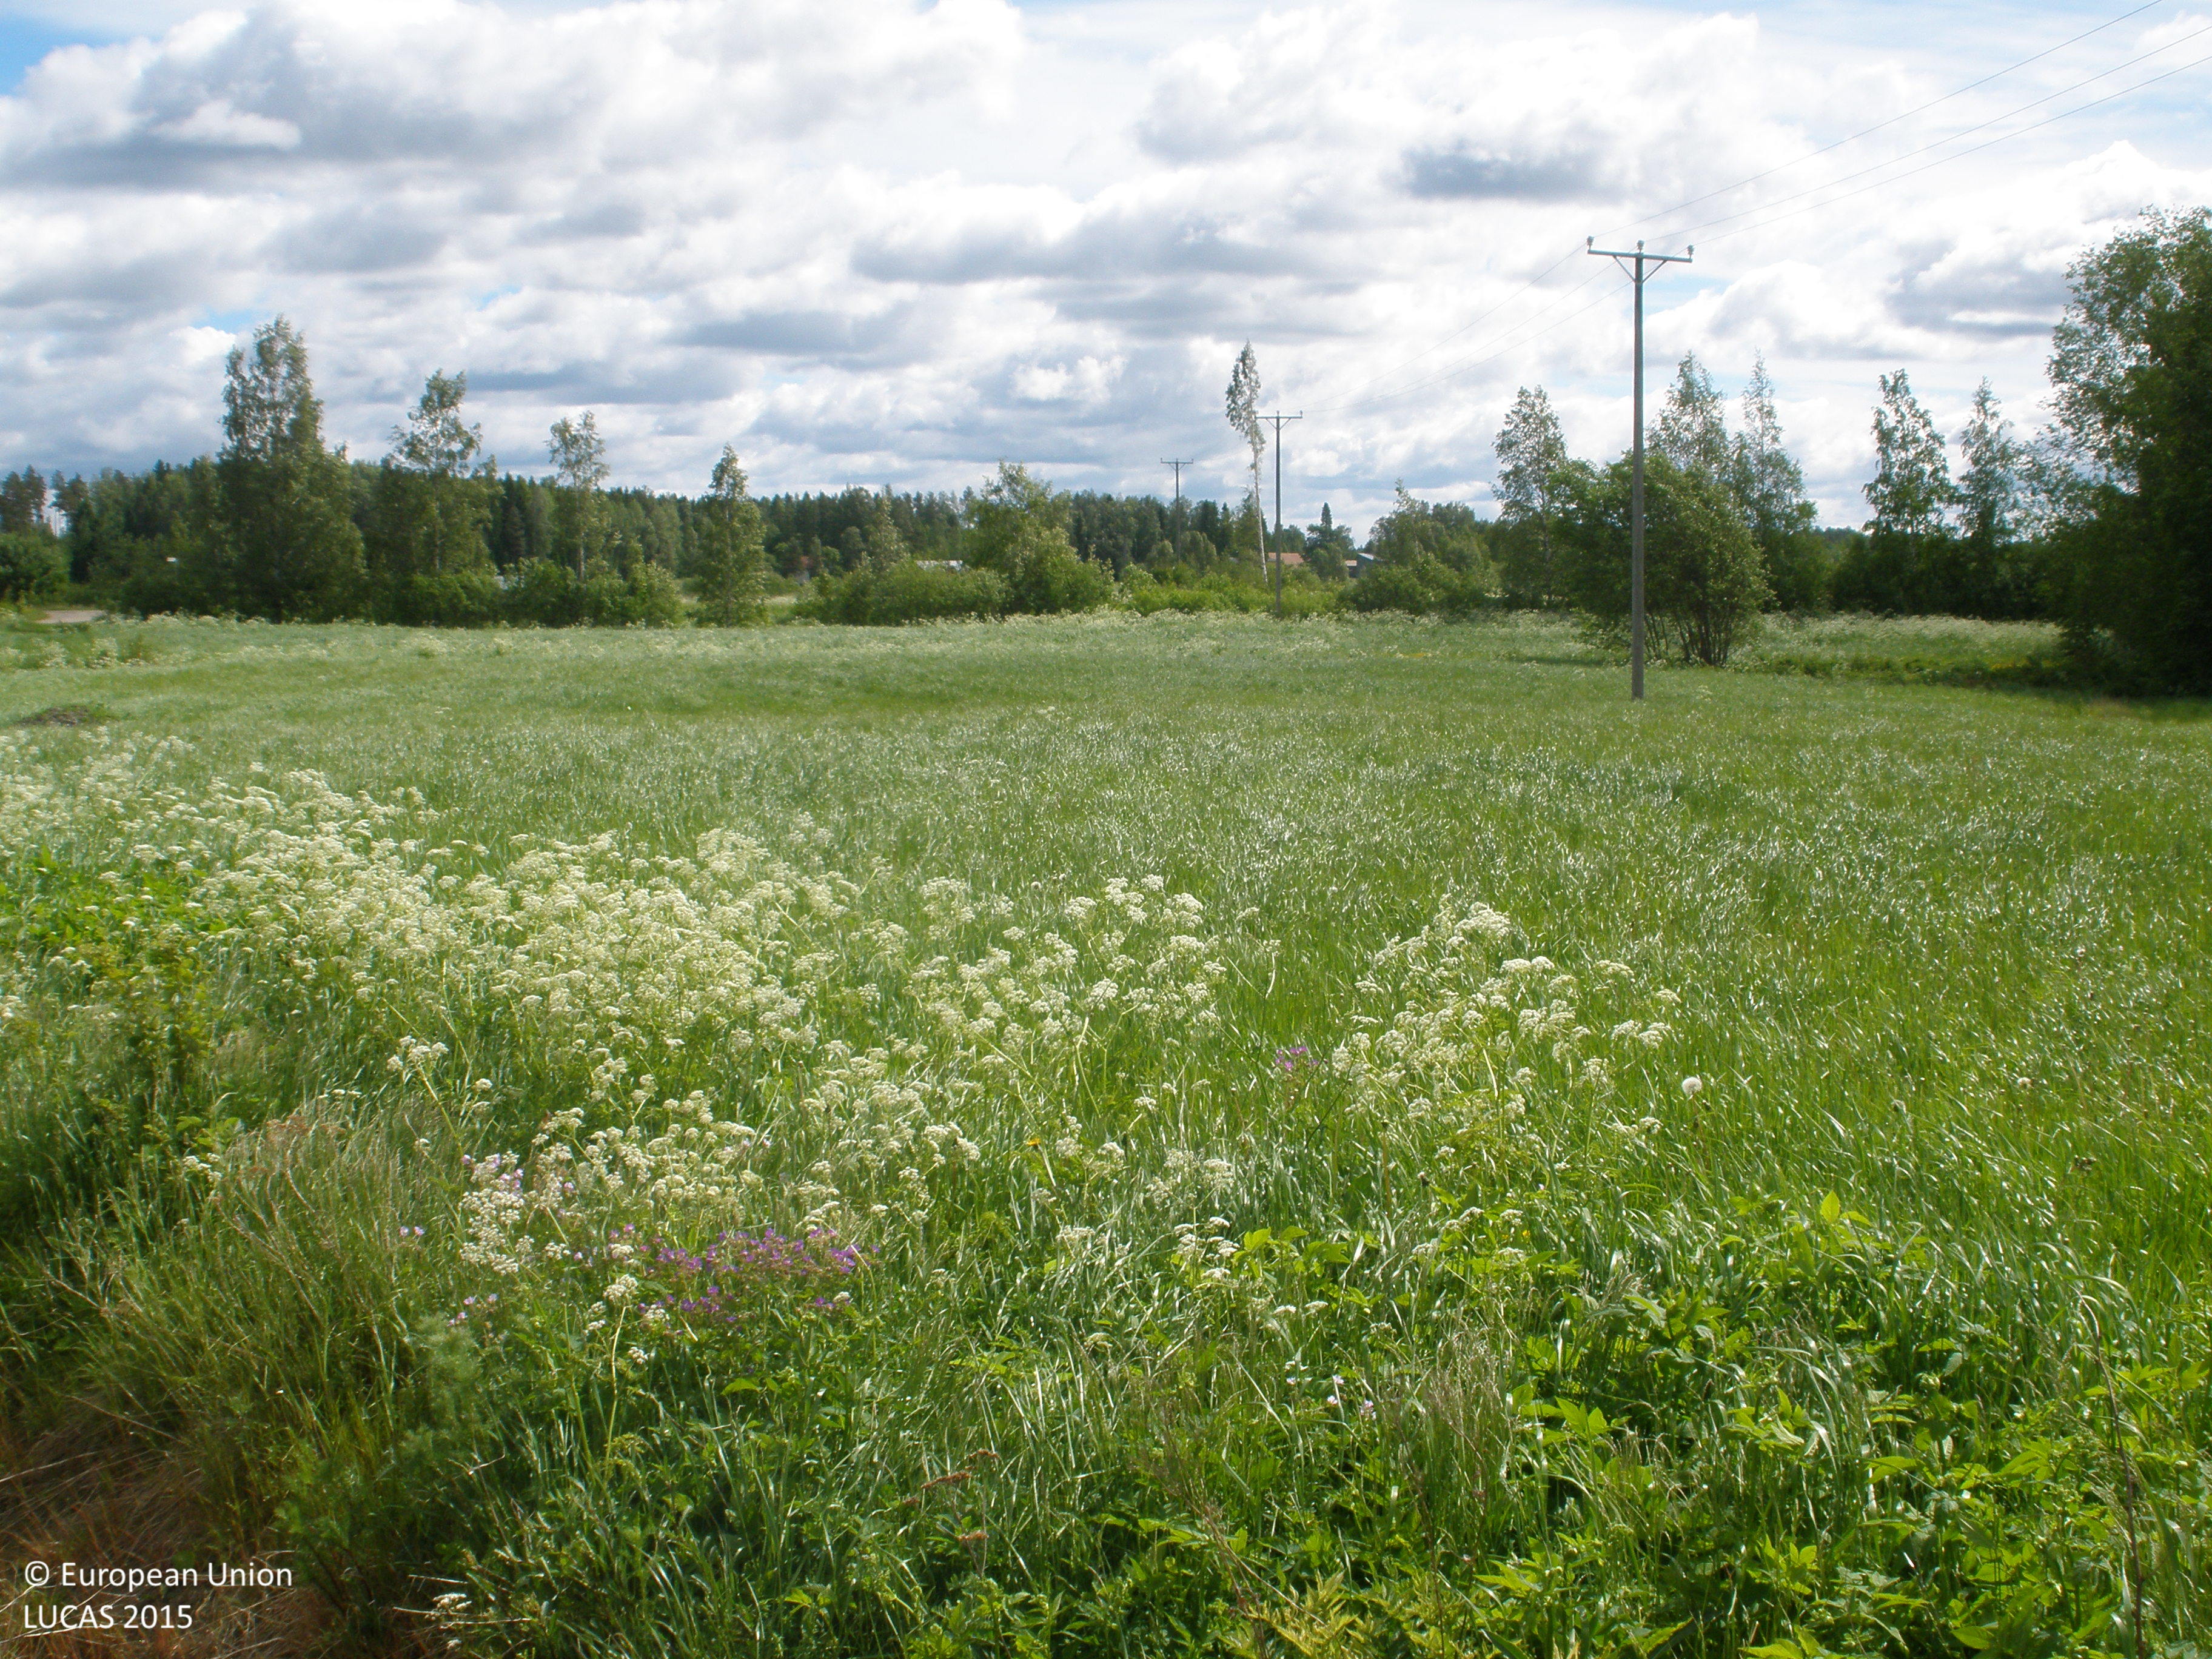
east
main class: Cropland
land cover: Rye
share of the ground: 10 - 25 %
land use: Agriculture (excluding fallow land and kitchen gardens)
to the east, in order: Rye; Ditches and canals; Spontaneously vegetated surfaces; Electric lines; Spontaneously vegetated surfaces; Ditches and canals; Spontaneously vegetated surfaces; Ditches and canals; Paved roads, cycling and walking lanes; Ditches and canals; Spontaneously vegetated surfaces; Rye
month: June
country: FI
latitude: 61.2078
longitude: 24.4882
